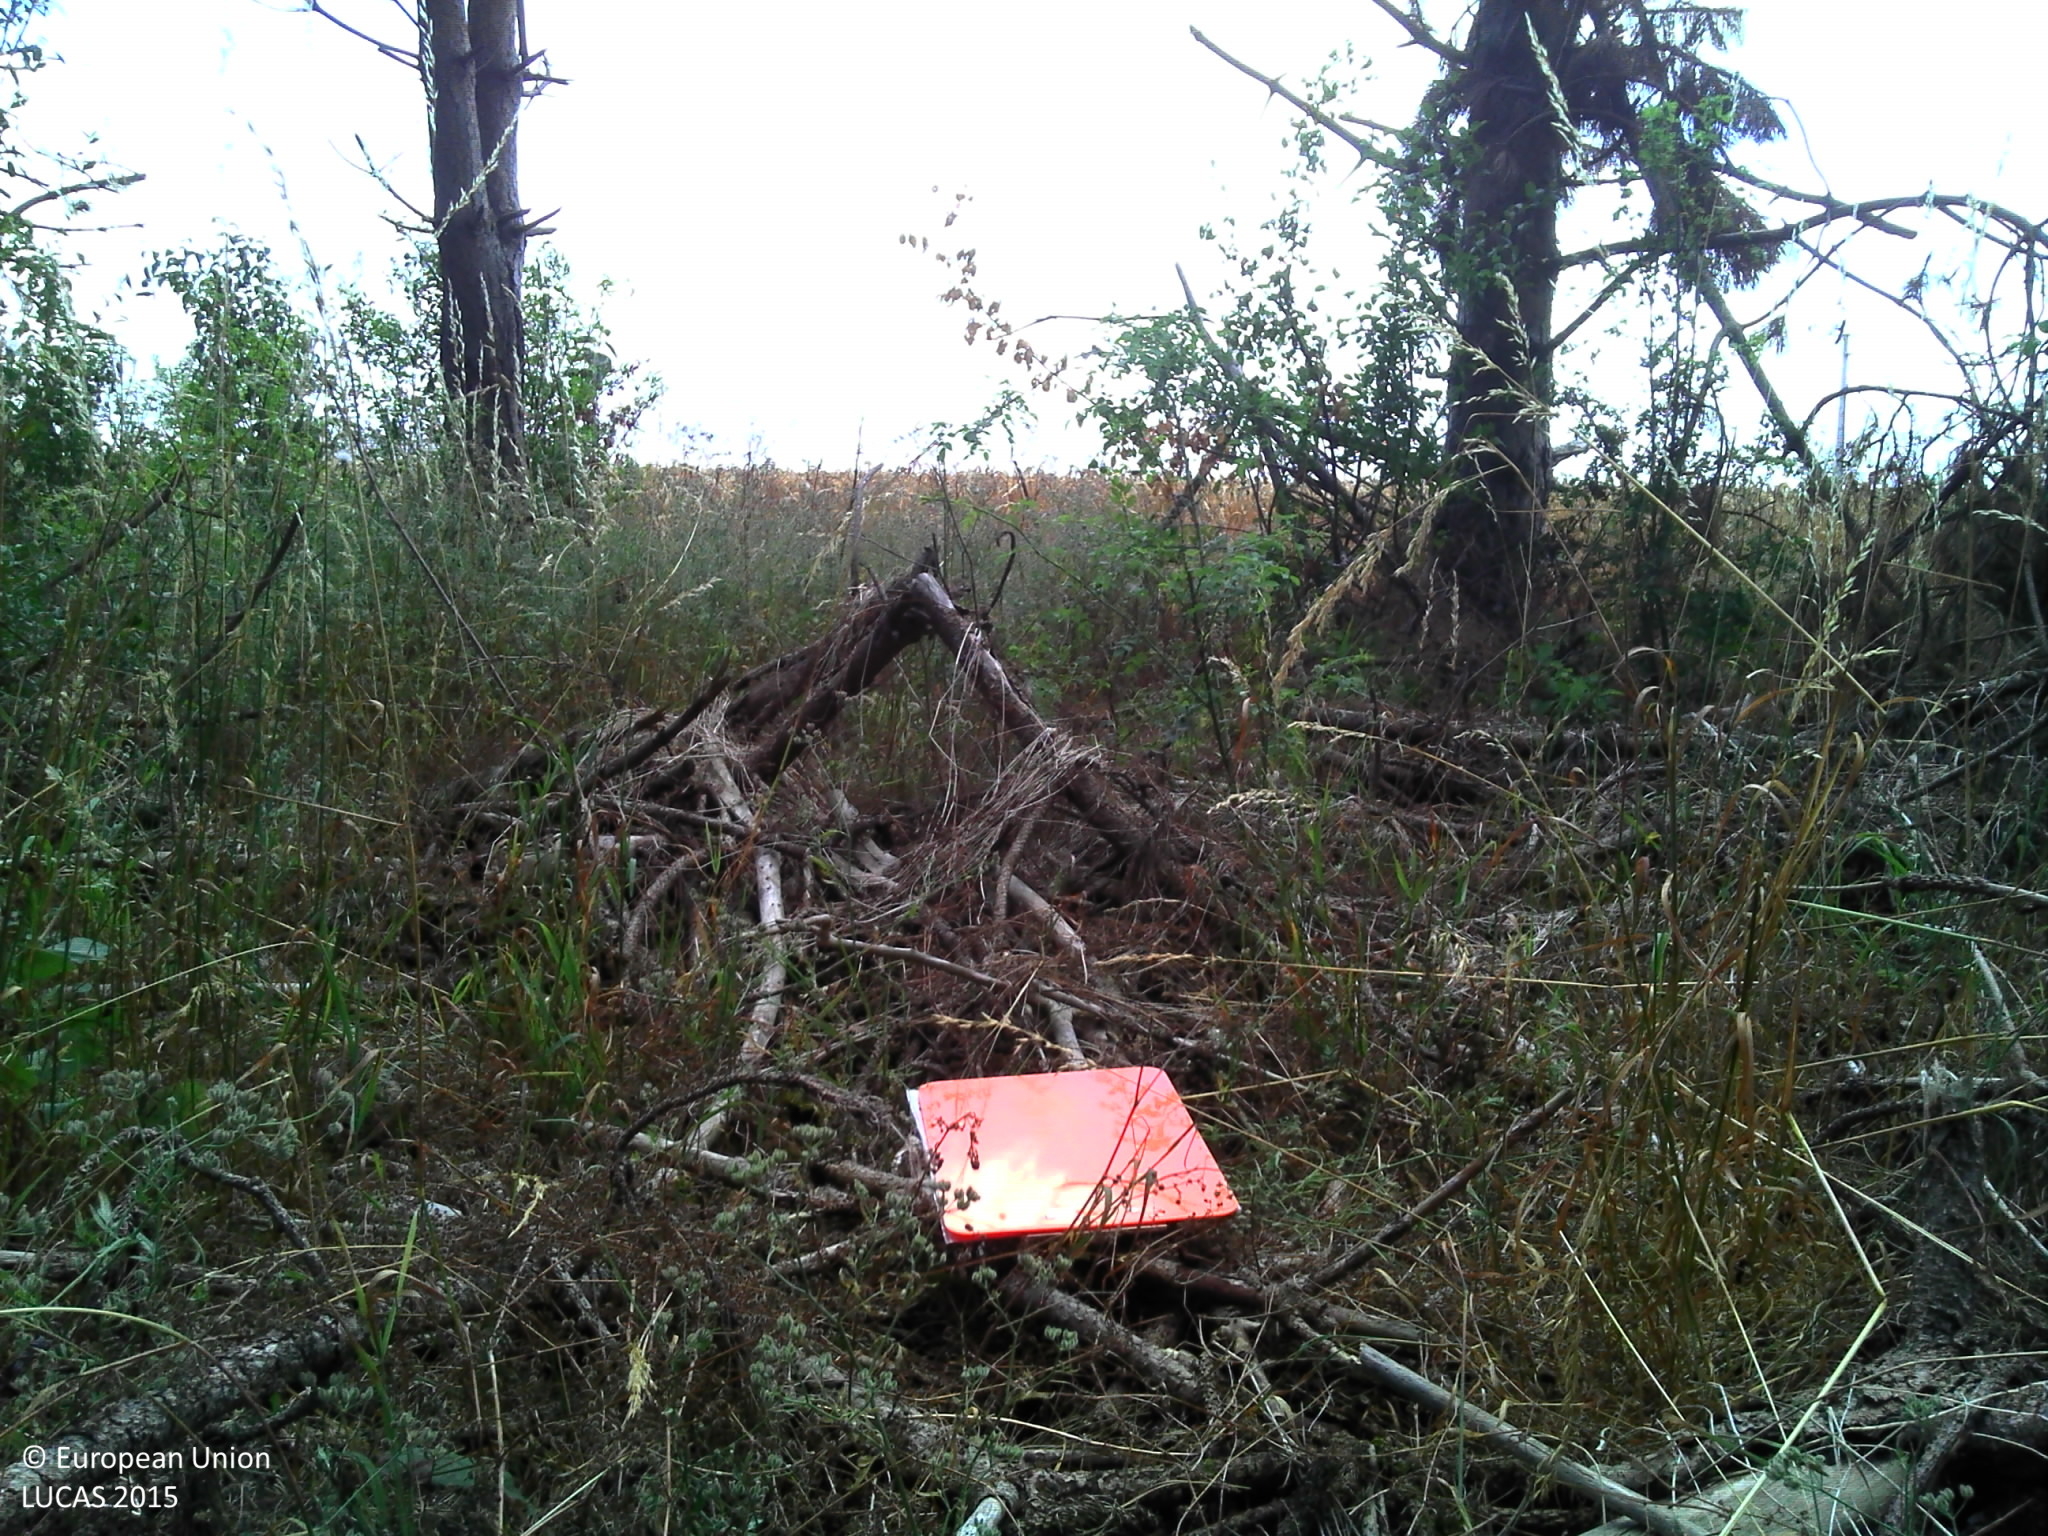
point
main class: Woodland
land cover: Pine dominated coniferous woodland
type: boreal forest
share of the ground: > 75 %
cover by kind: coniferous forest trees 60 %, herbaceous plants 30 %, lichens and mosses 5 %, unconsolidated bare surface 5 %
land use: Forestry
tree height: > 5 m
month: July
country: FR
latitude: 49.3859
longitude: 4.1681
